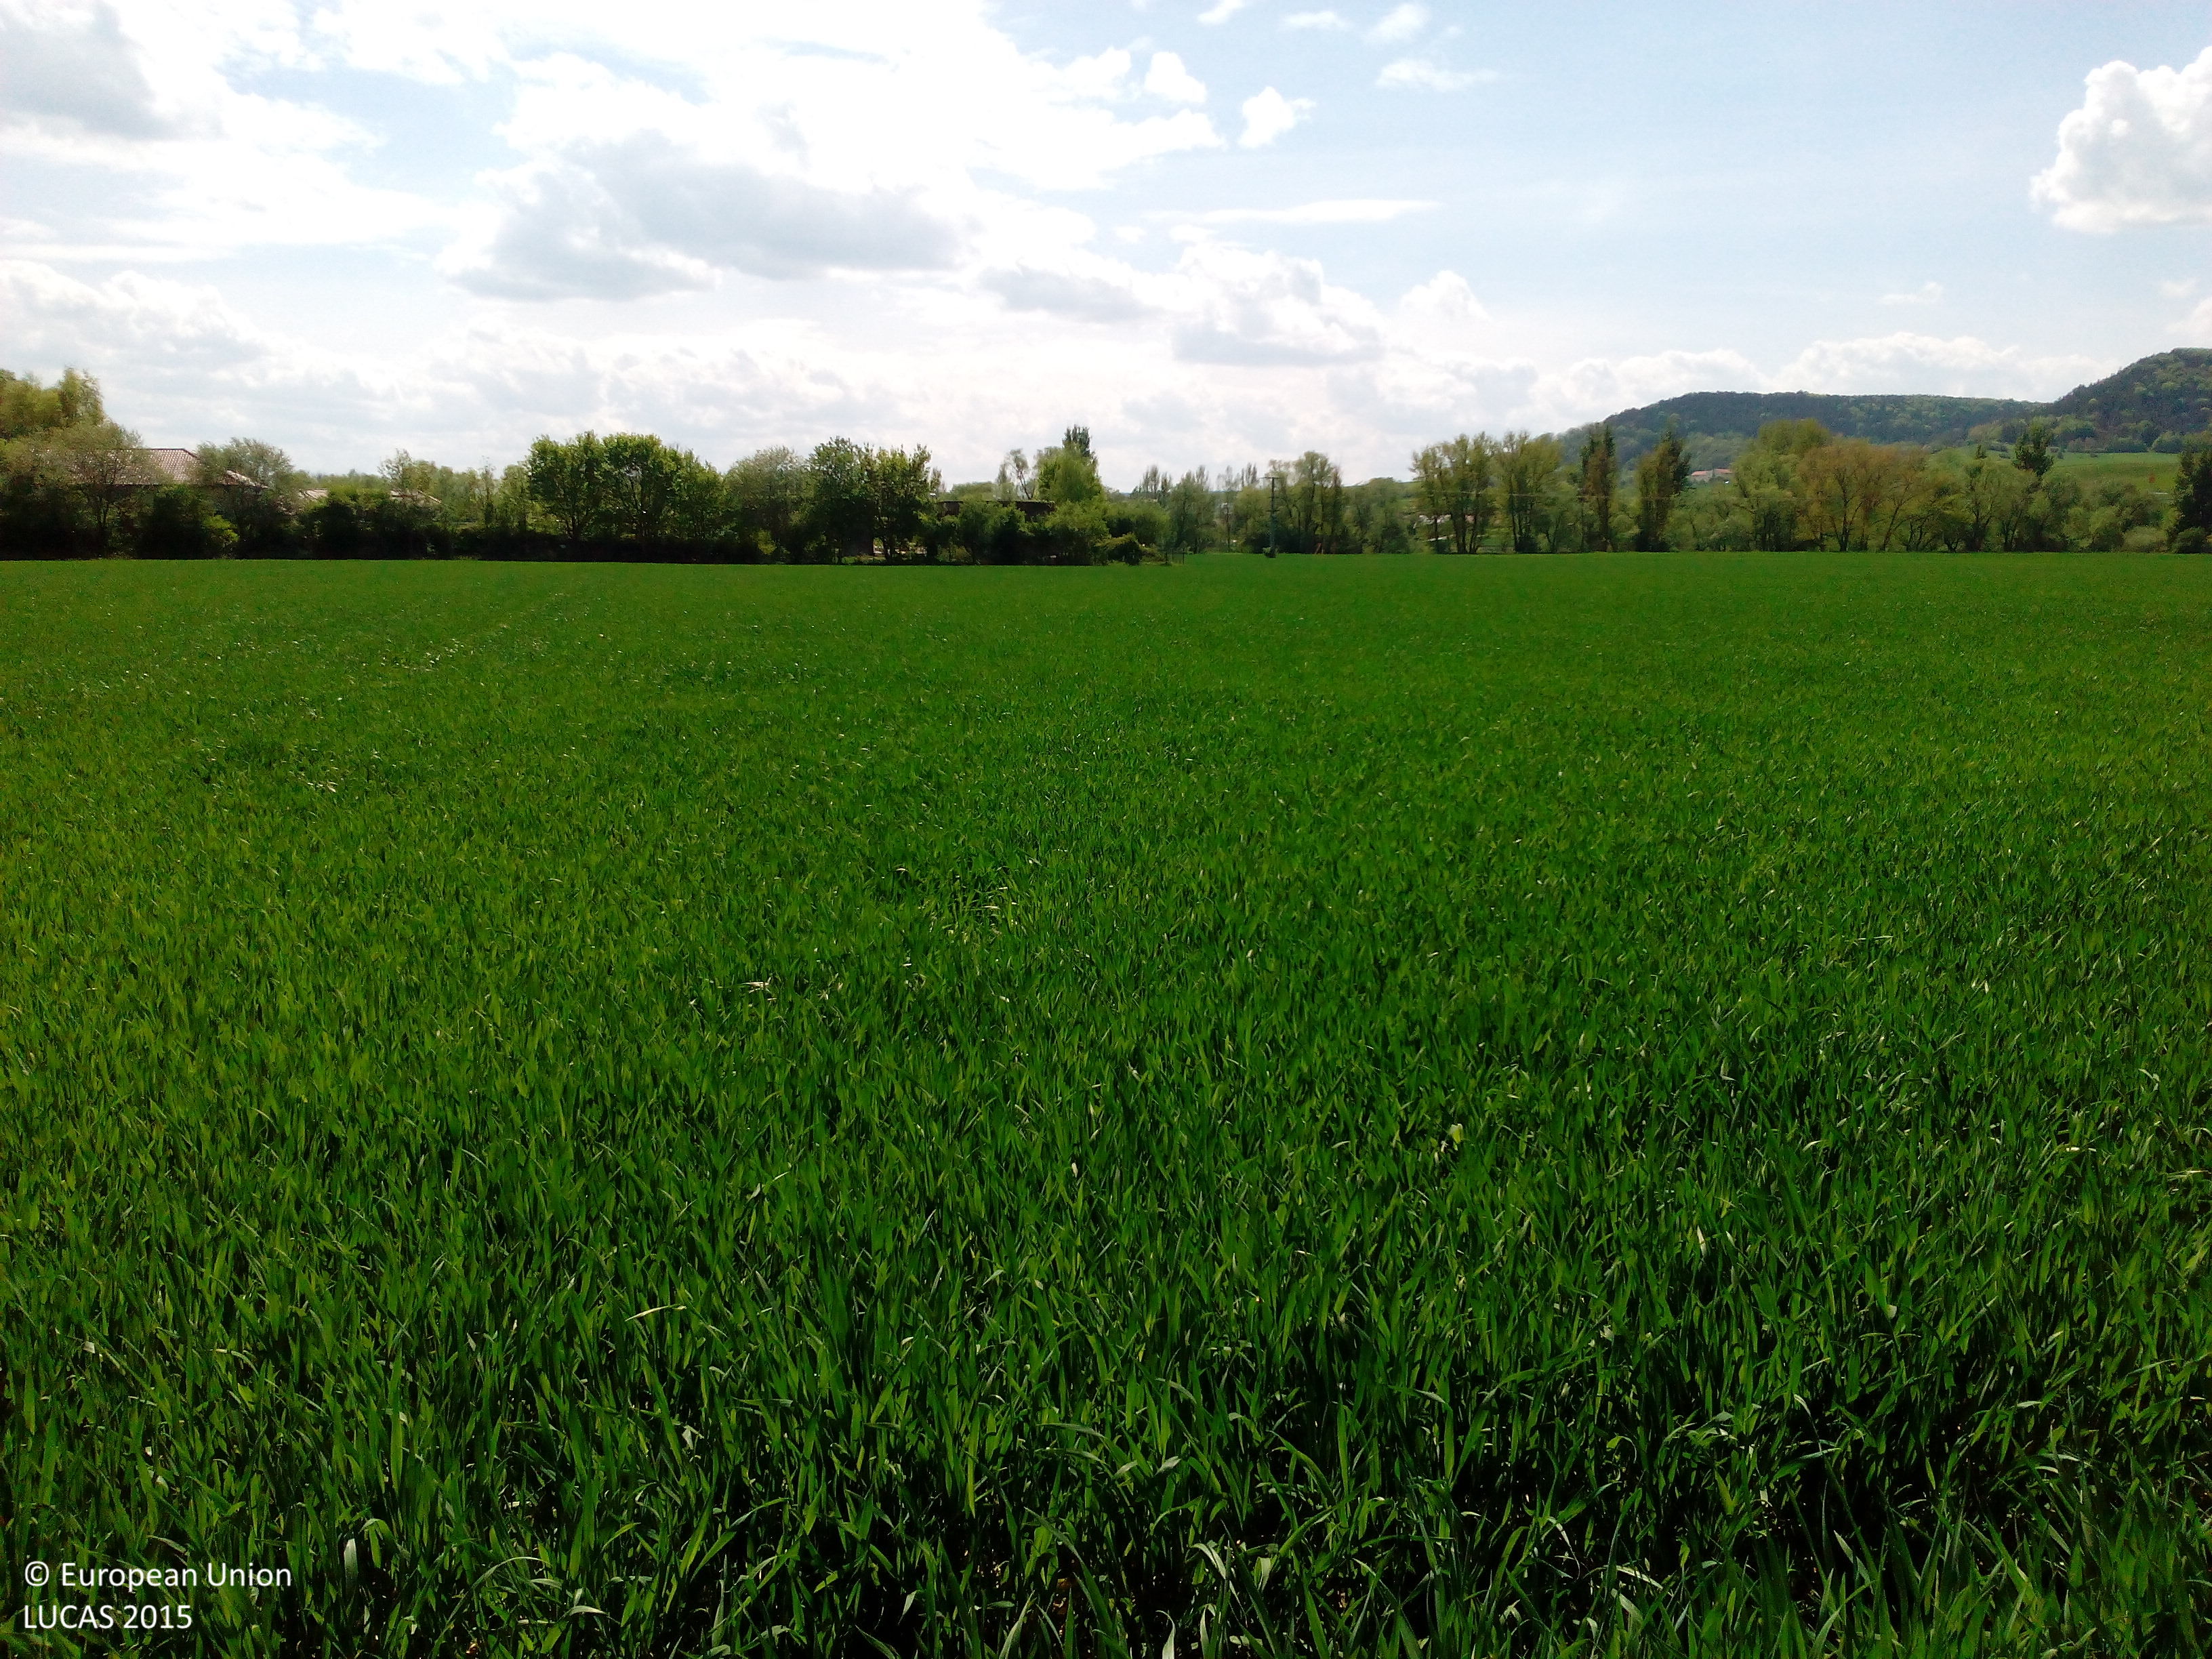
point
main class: Cropland
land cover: Common wheat
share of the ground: > 75 %
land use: Agriculture (excluding fallow land and kitchen gardens)
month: May
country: DE
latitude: 50.8743
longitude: 11.6055
